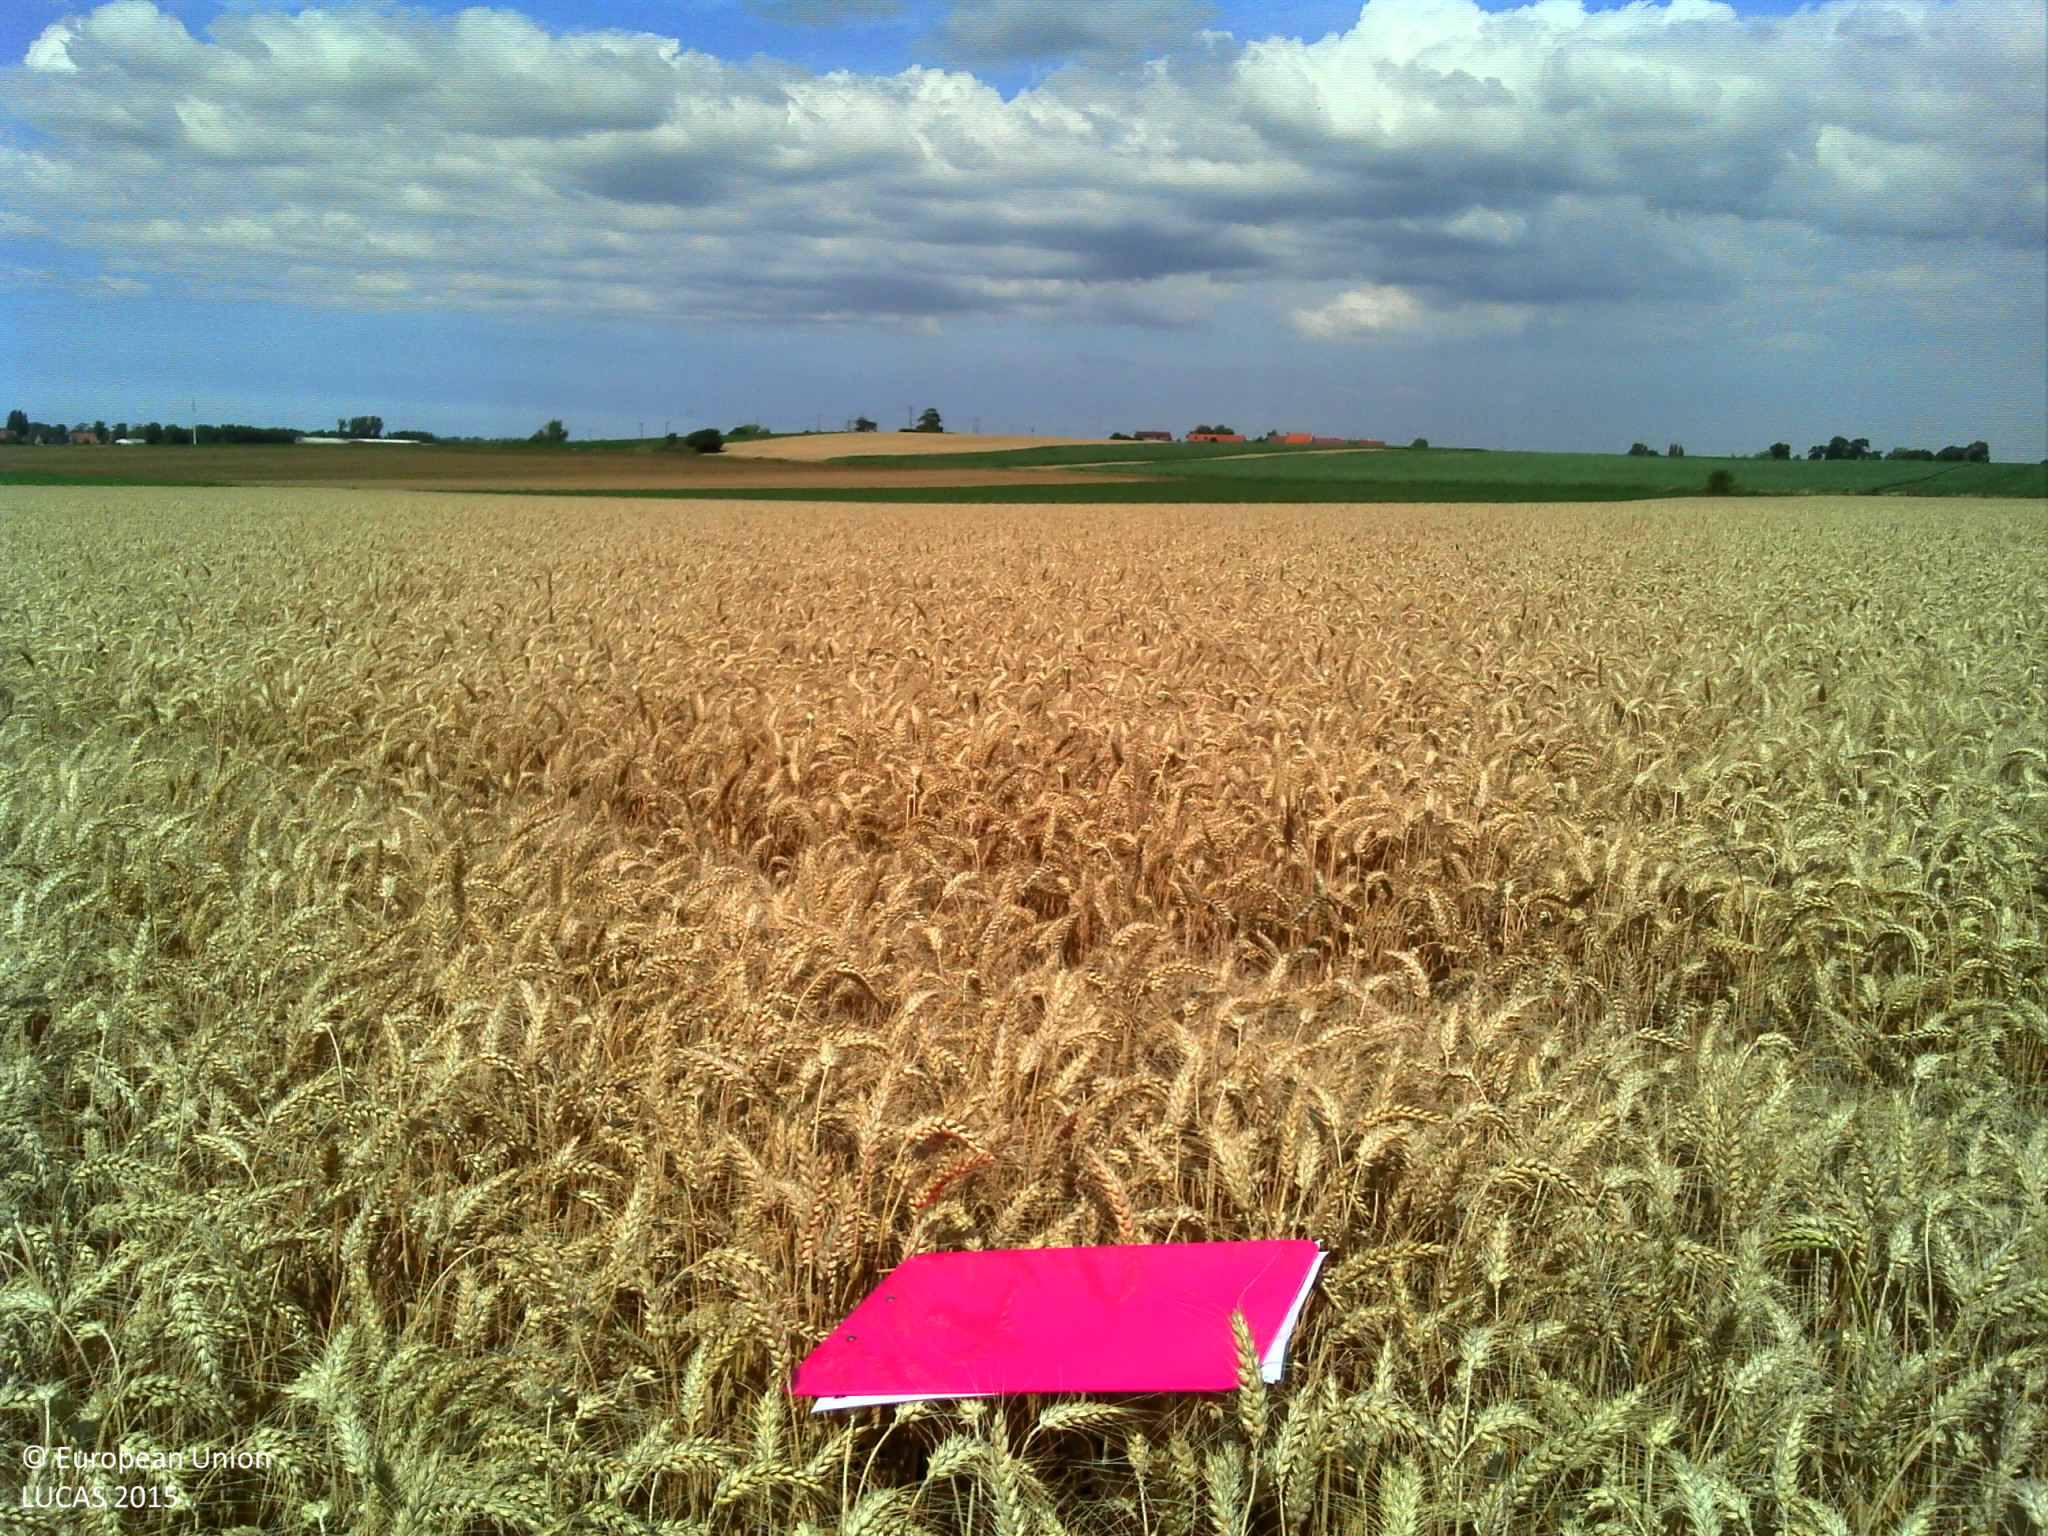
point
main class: Cropland
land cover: Common wheat
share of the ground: > 75 %
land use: Agriculture (excluding fallow land and kitchen gardens)
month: July
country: FR
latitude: 50.8168
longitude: 2.4215
